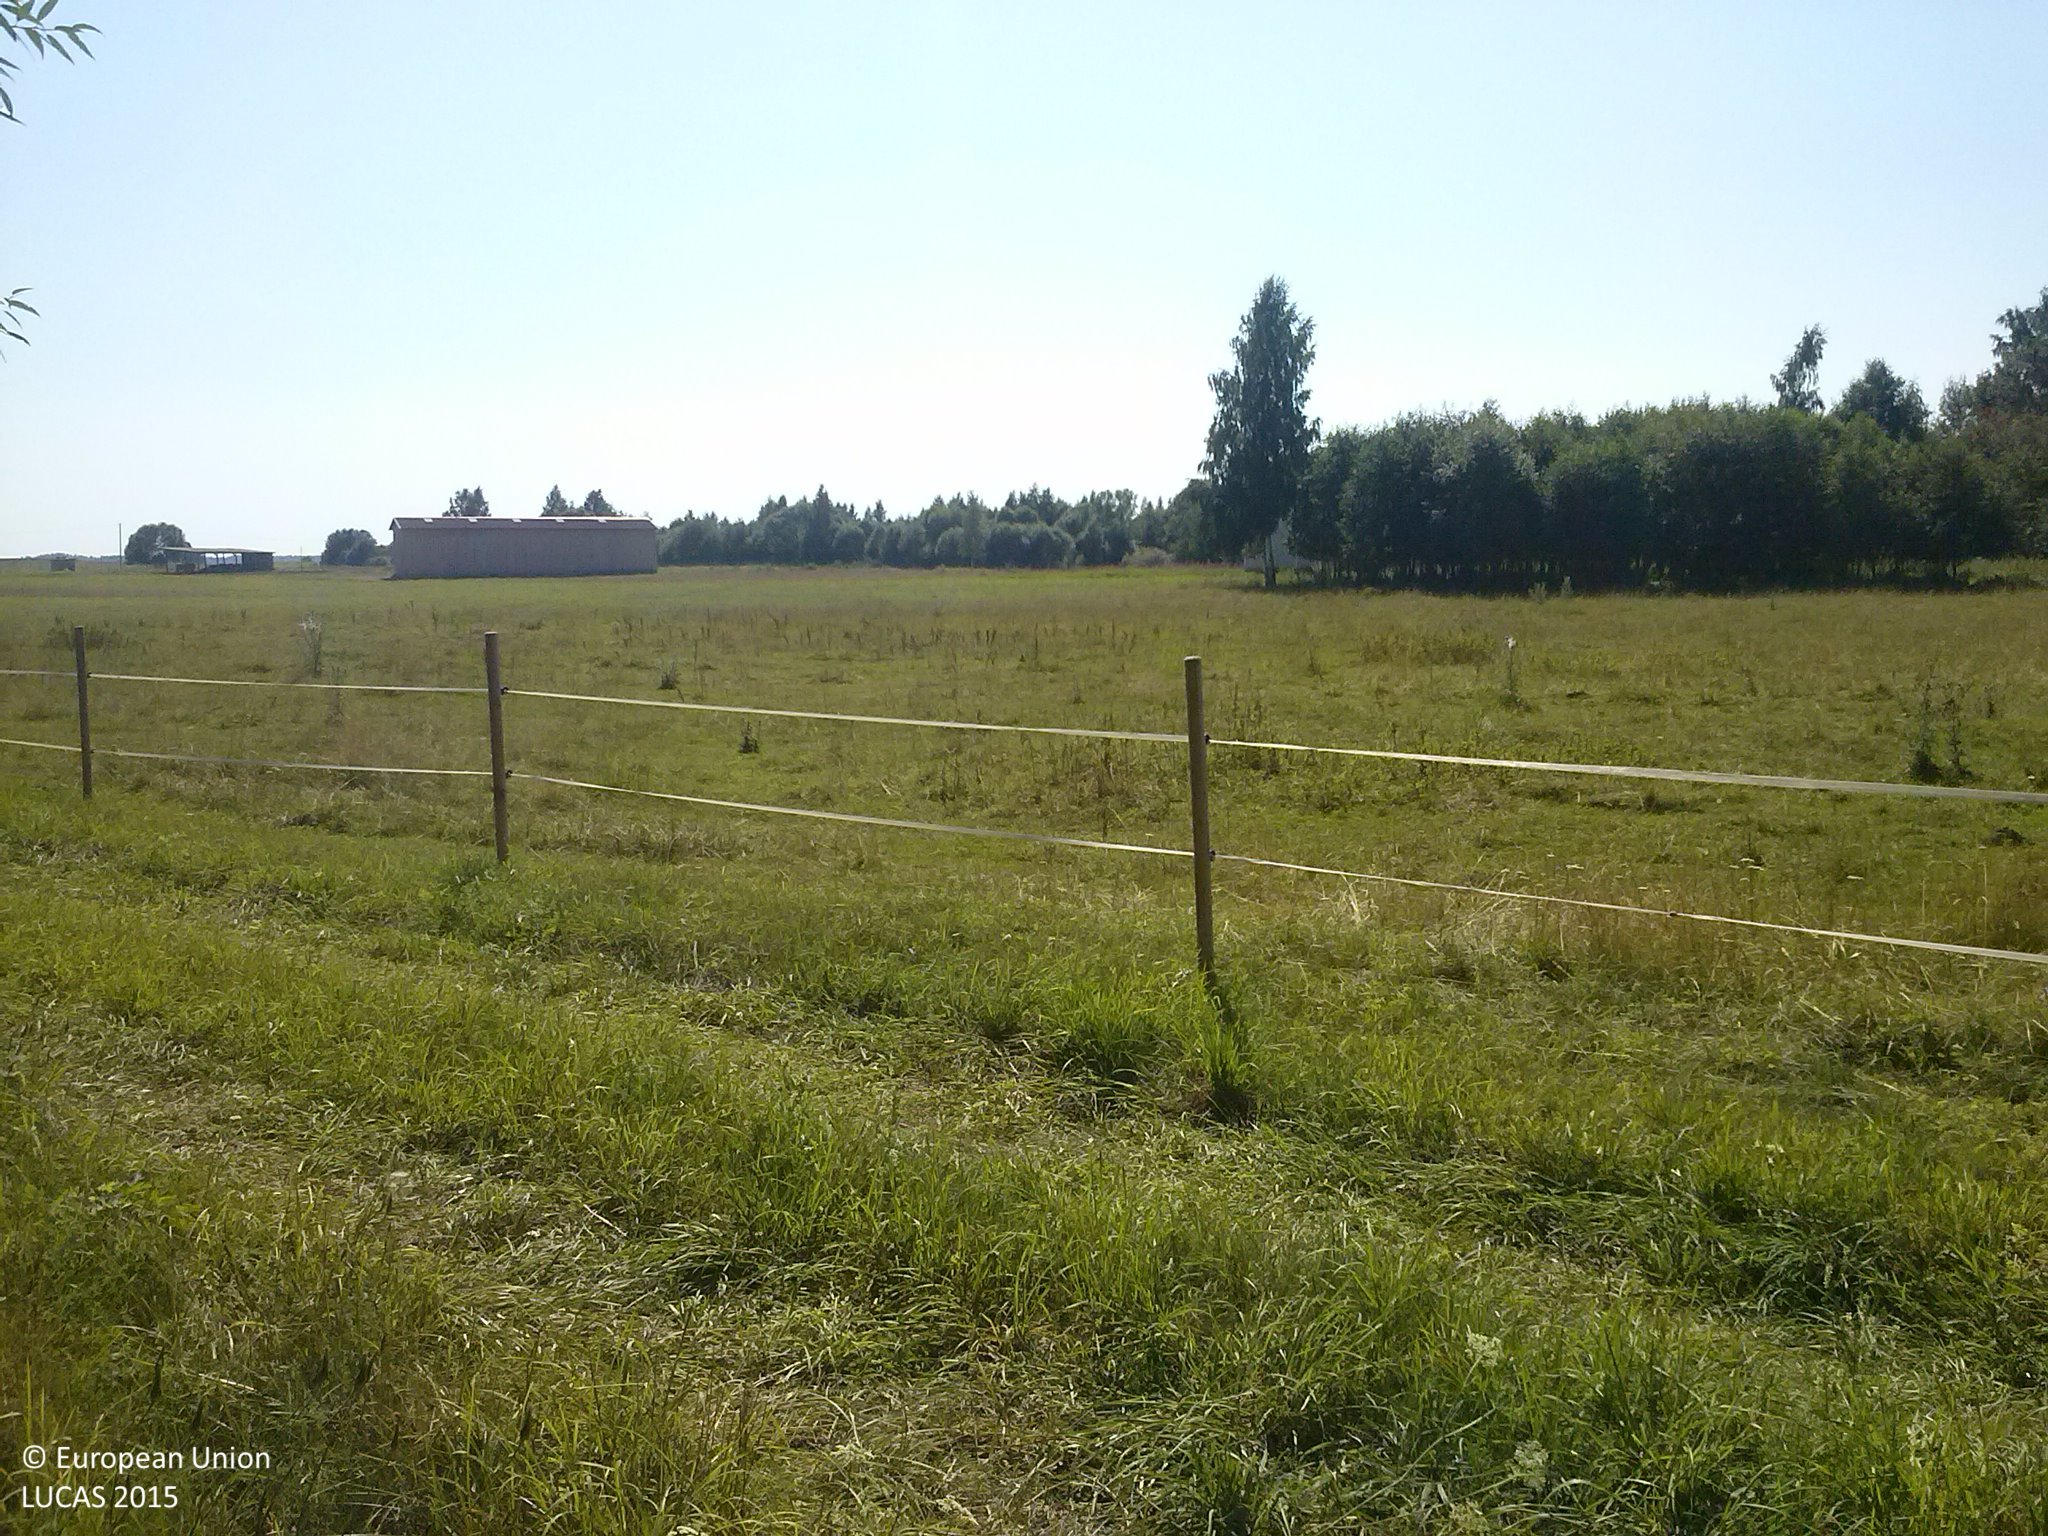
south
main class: Grassland
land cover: Grassland without tree/shrub cover
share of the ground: > 75 %
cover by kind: herbaceous plants 100 %
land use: Agriculture (excluding fallow land and kitchen gardens)
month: August
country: LV
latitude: 56.7259
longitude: 27.7552
